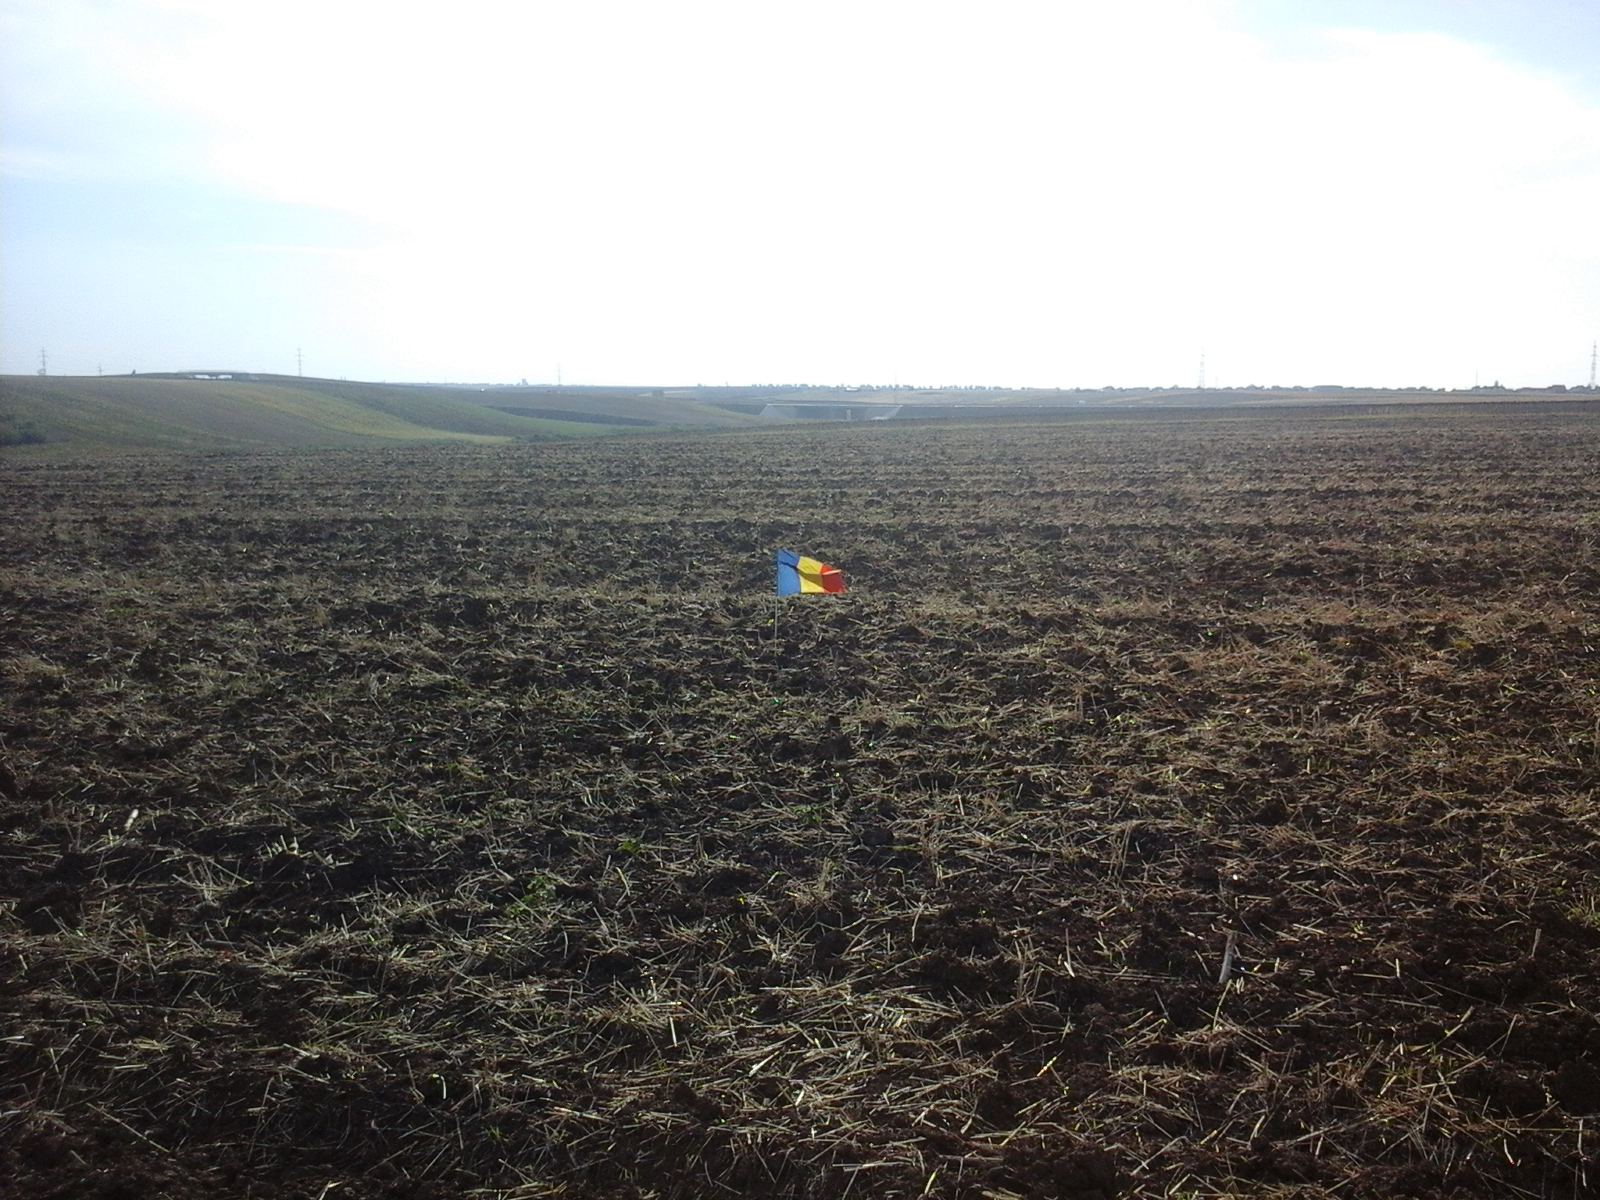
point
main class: Cropland
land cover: Common wheat
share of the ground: < 10 %
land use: Agriculture (excluding fallow land and kitchen gardens)
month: October
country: RO
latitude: 46.0575
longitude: 21.3175
